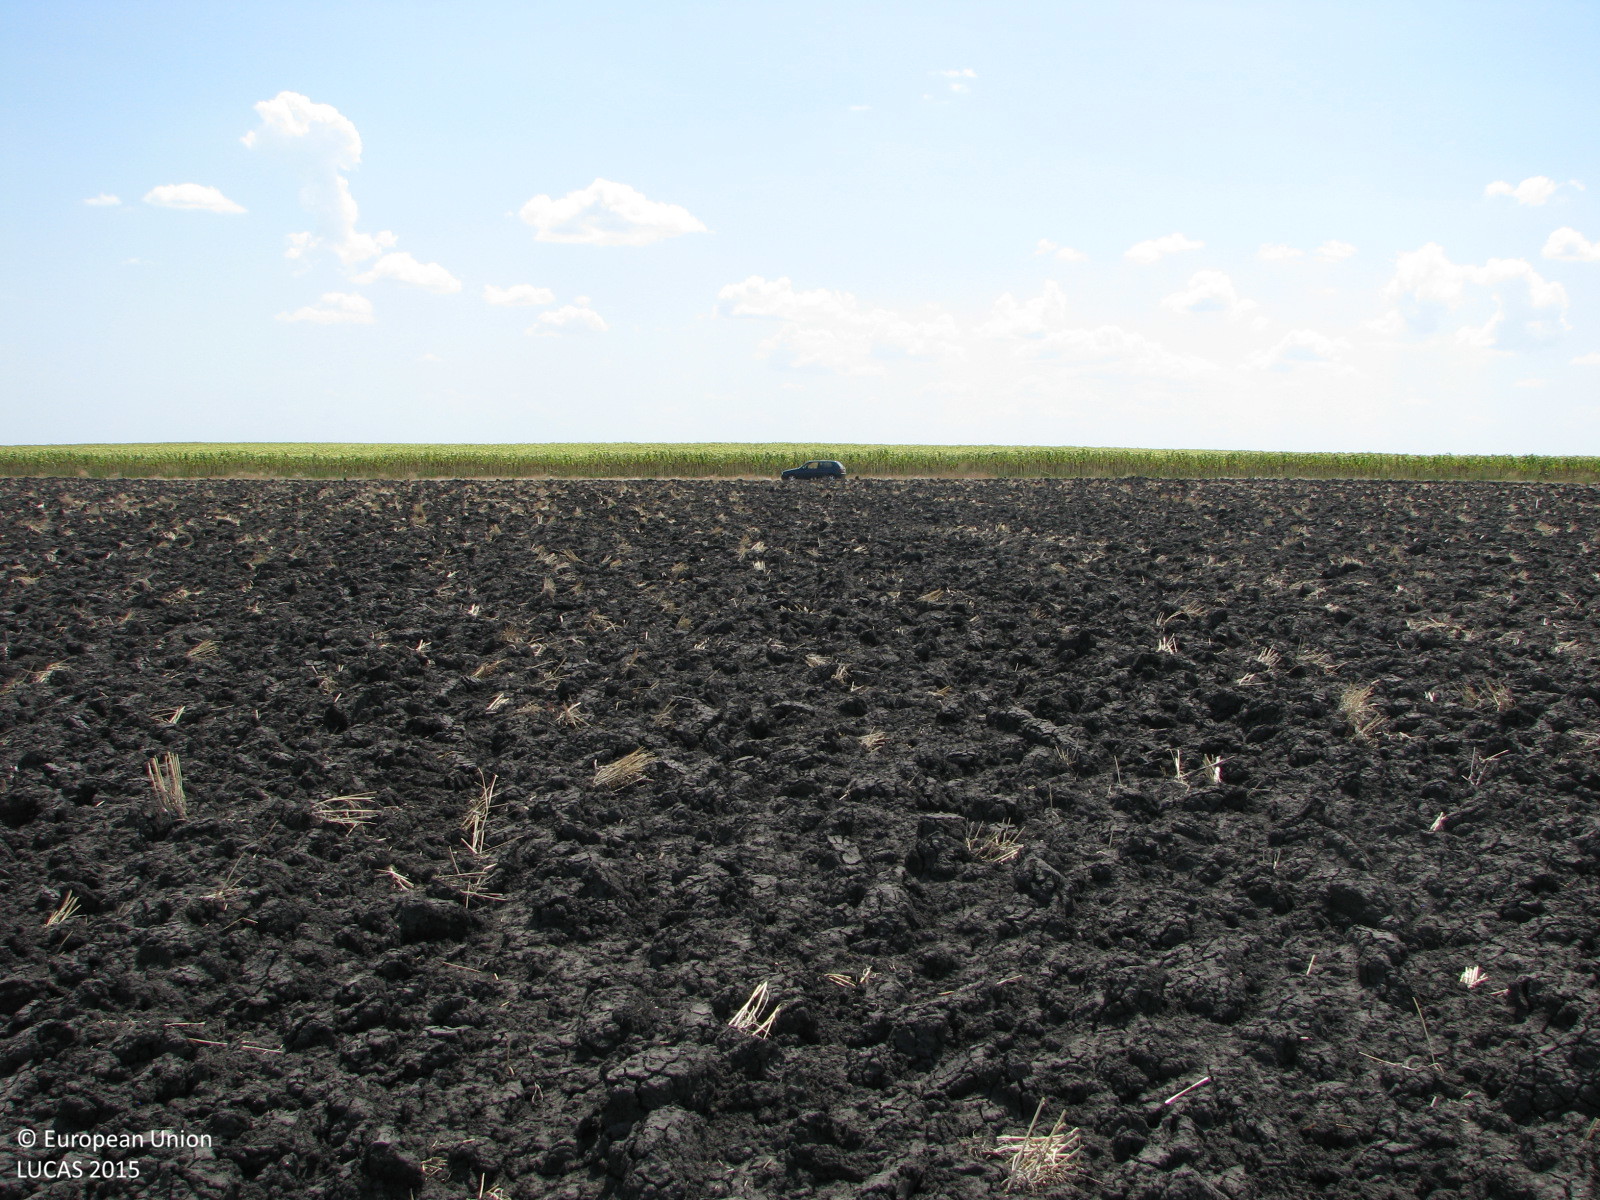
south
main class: Cropland
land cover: Common wheat
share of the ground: < 10 %
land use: Agriculture (excluding fallow land and kitchen gardens)
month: August
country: BG
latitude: 42.4184
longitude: 26.4600
